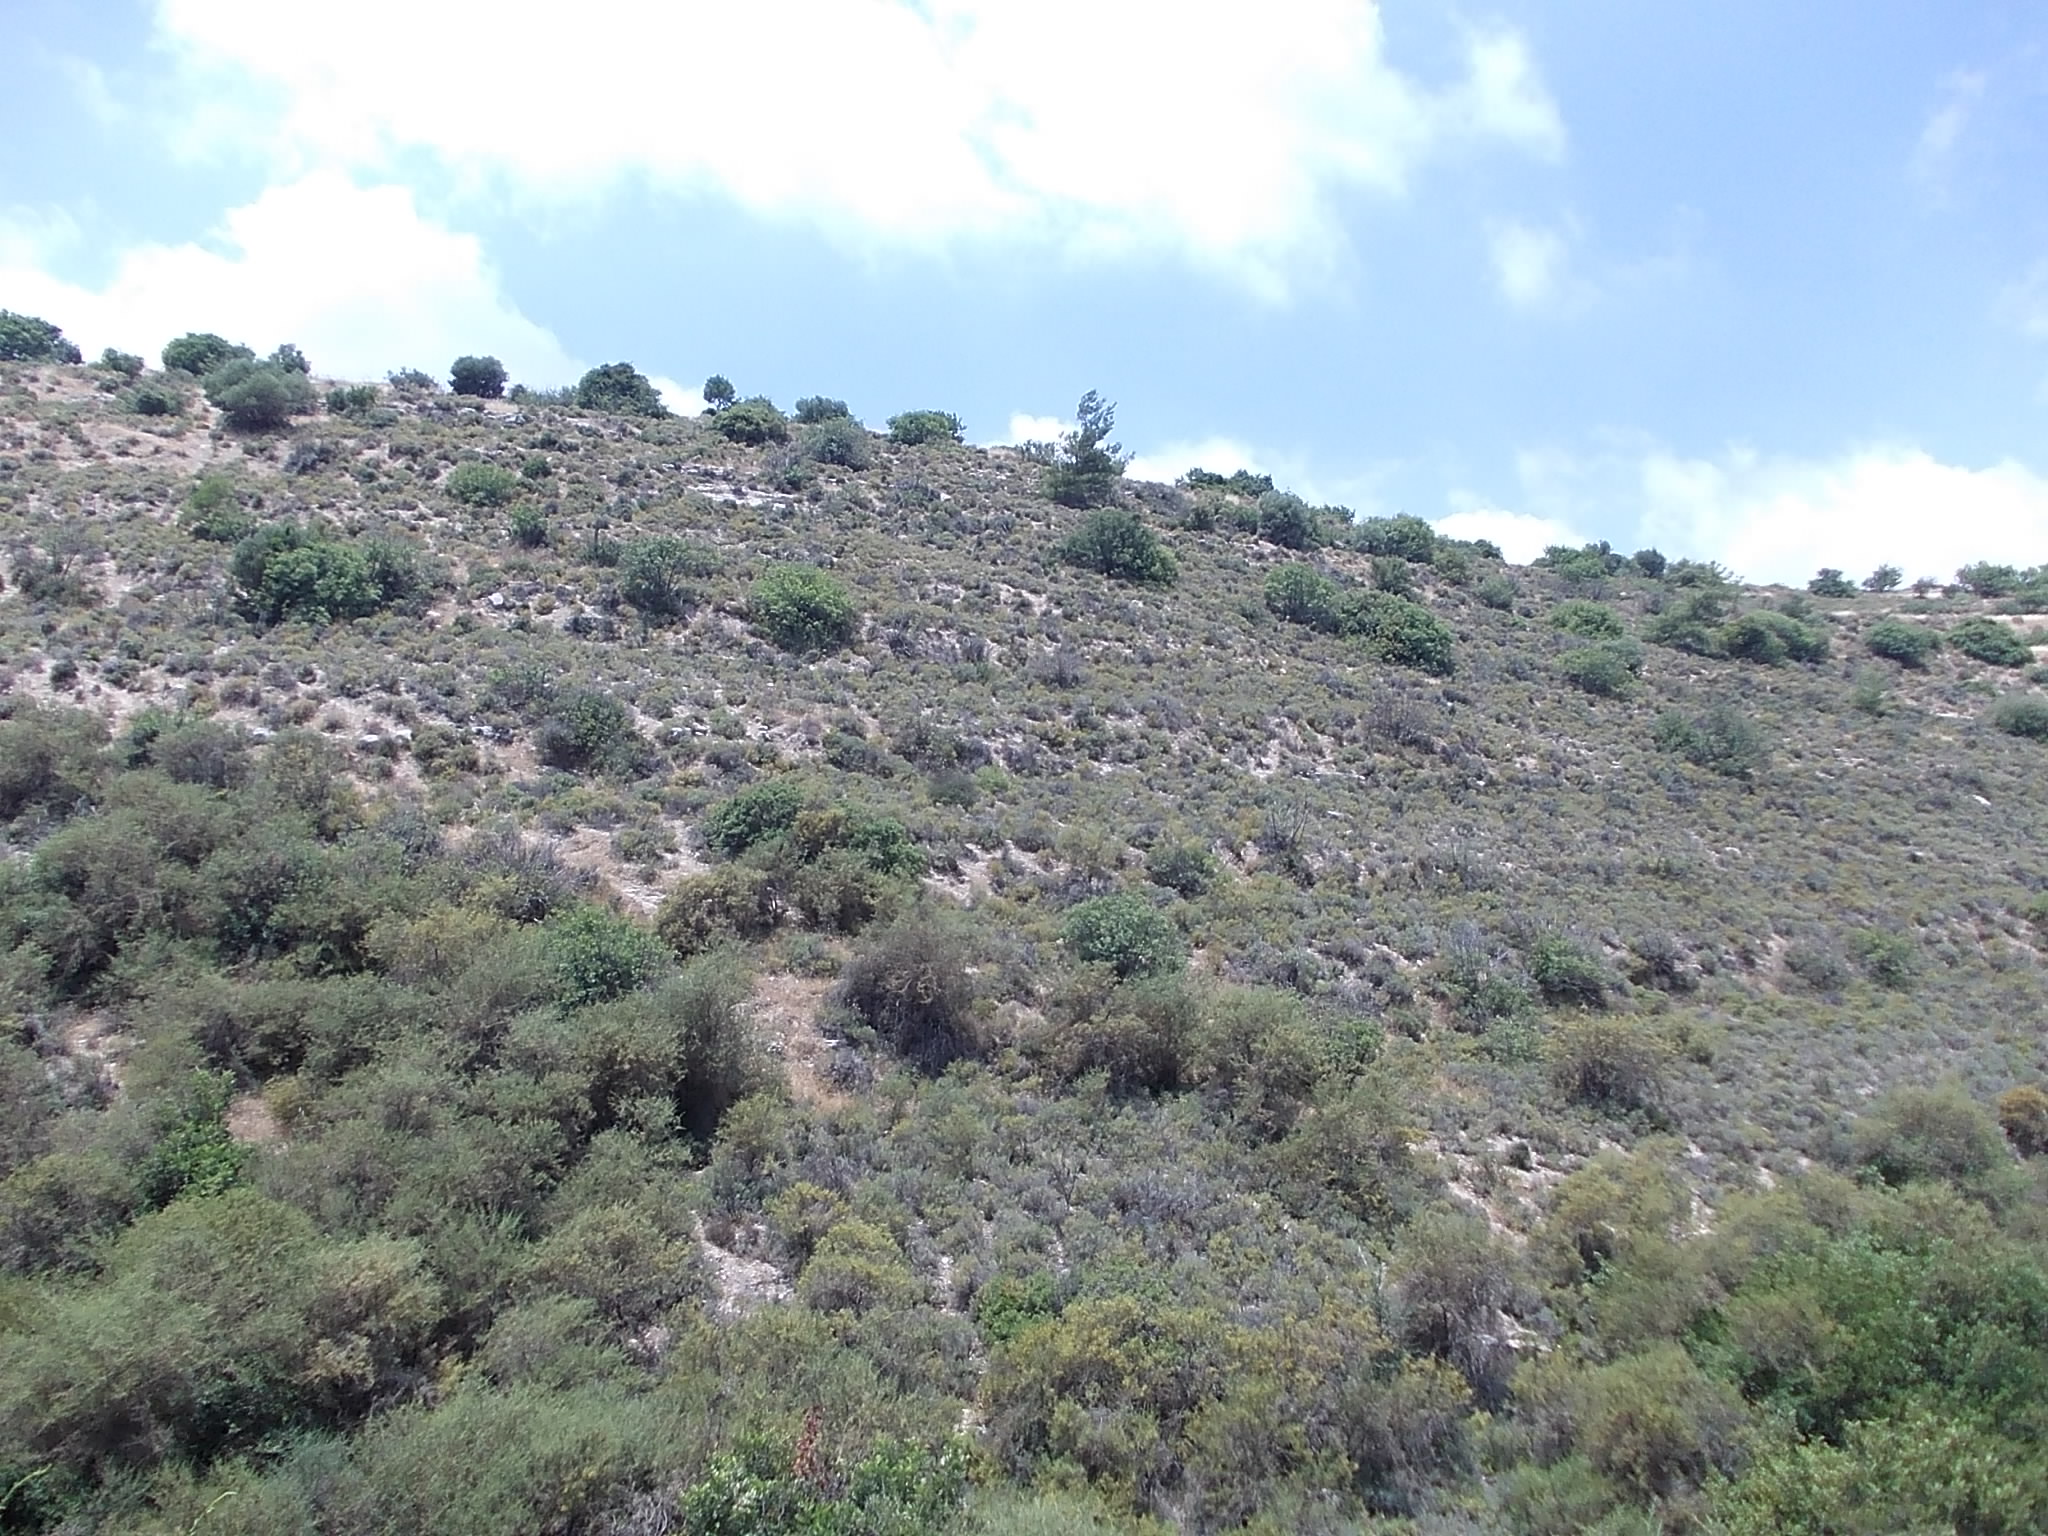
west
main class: Shrubland
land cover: Shrubland without tree cover
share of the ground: > 75 %
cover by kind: shrubs 85 %, herbaceous plants 10 %, unconsolidated bare surface 5 %
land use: Semi-natural and natural areas not in use
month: June
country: CY
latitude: 34.7931
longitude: 32.9300
